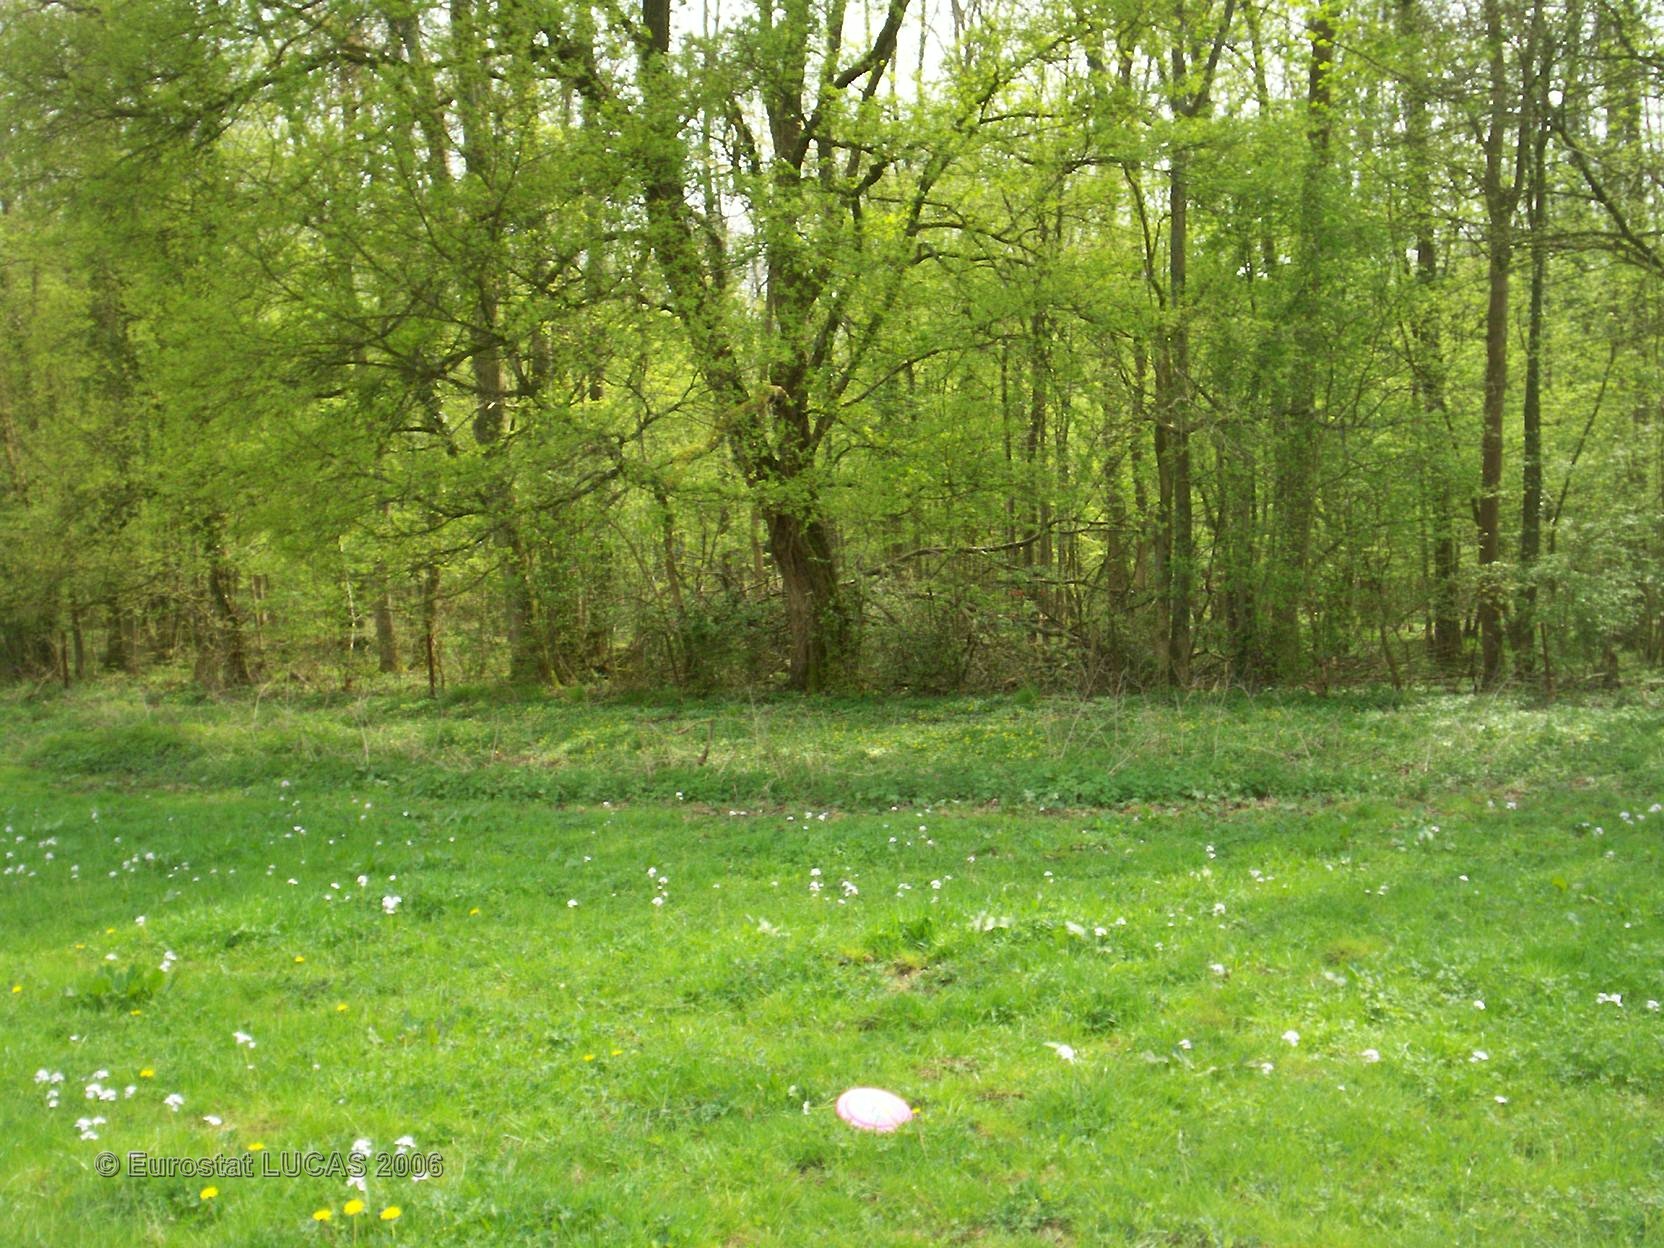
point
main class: Grassland
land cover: Grassland without tree/shrub cover
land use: Agriculture (excluding fallow land and kitchen gardens)
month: May
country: FR
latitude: 49.8824
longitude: 4.3592
